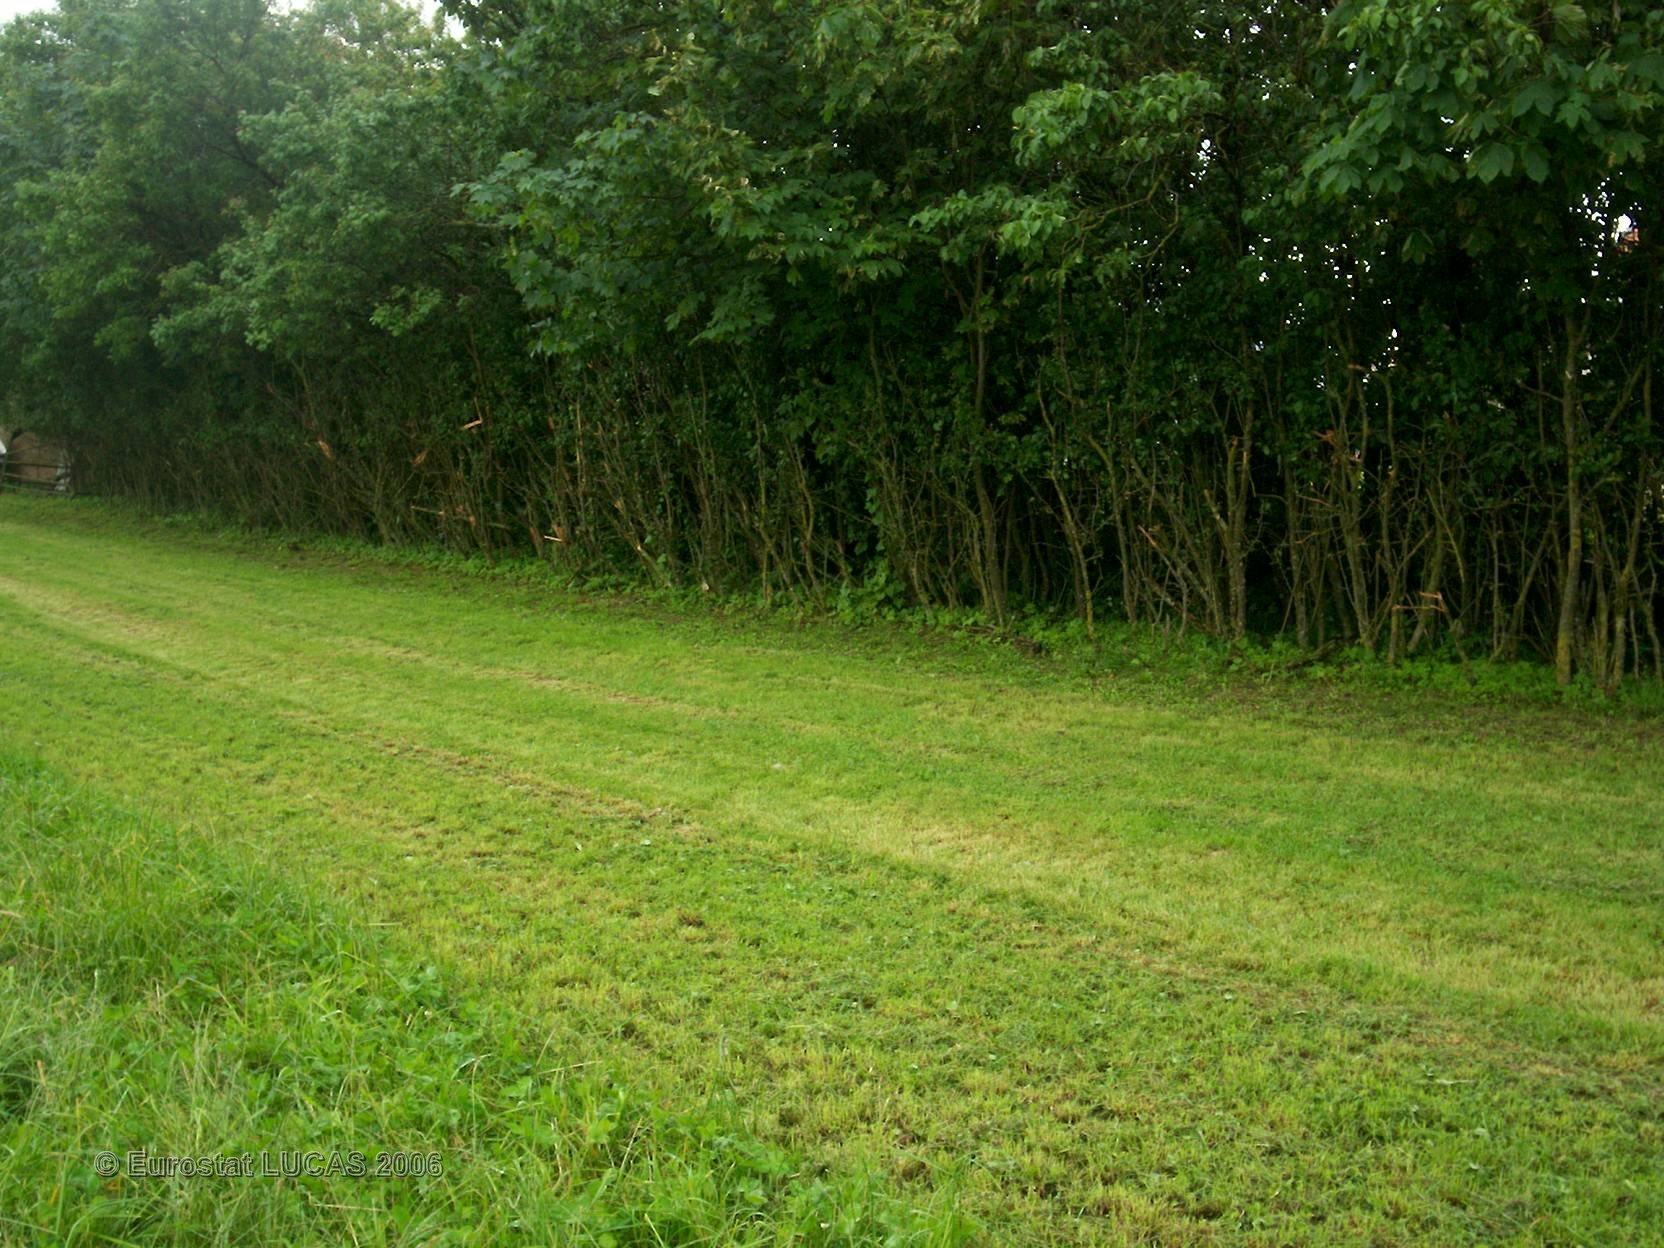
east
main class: Grassland
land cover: Grassland without tree/shrub cover
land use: Agriculture (excluding fallow land and kitchen gardens)
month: June
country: FR
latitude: 48.5530
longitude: 4.4560
